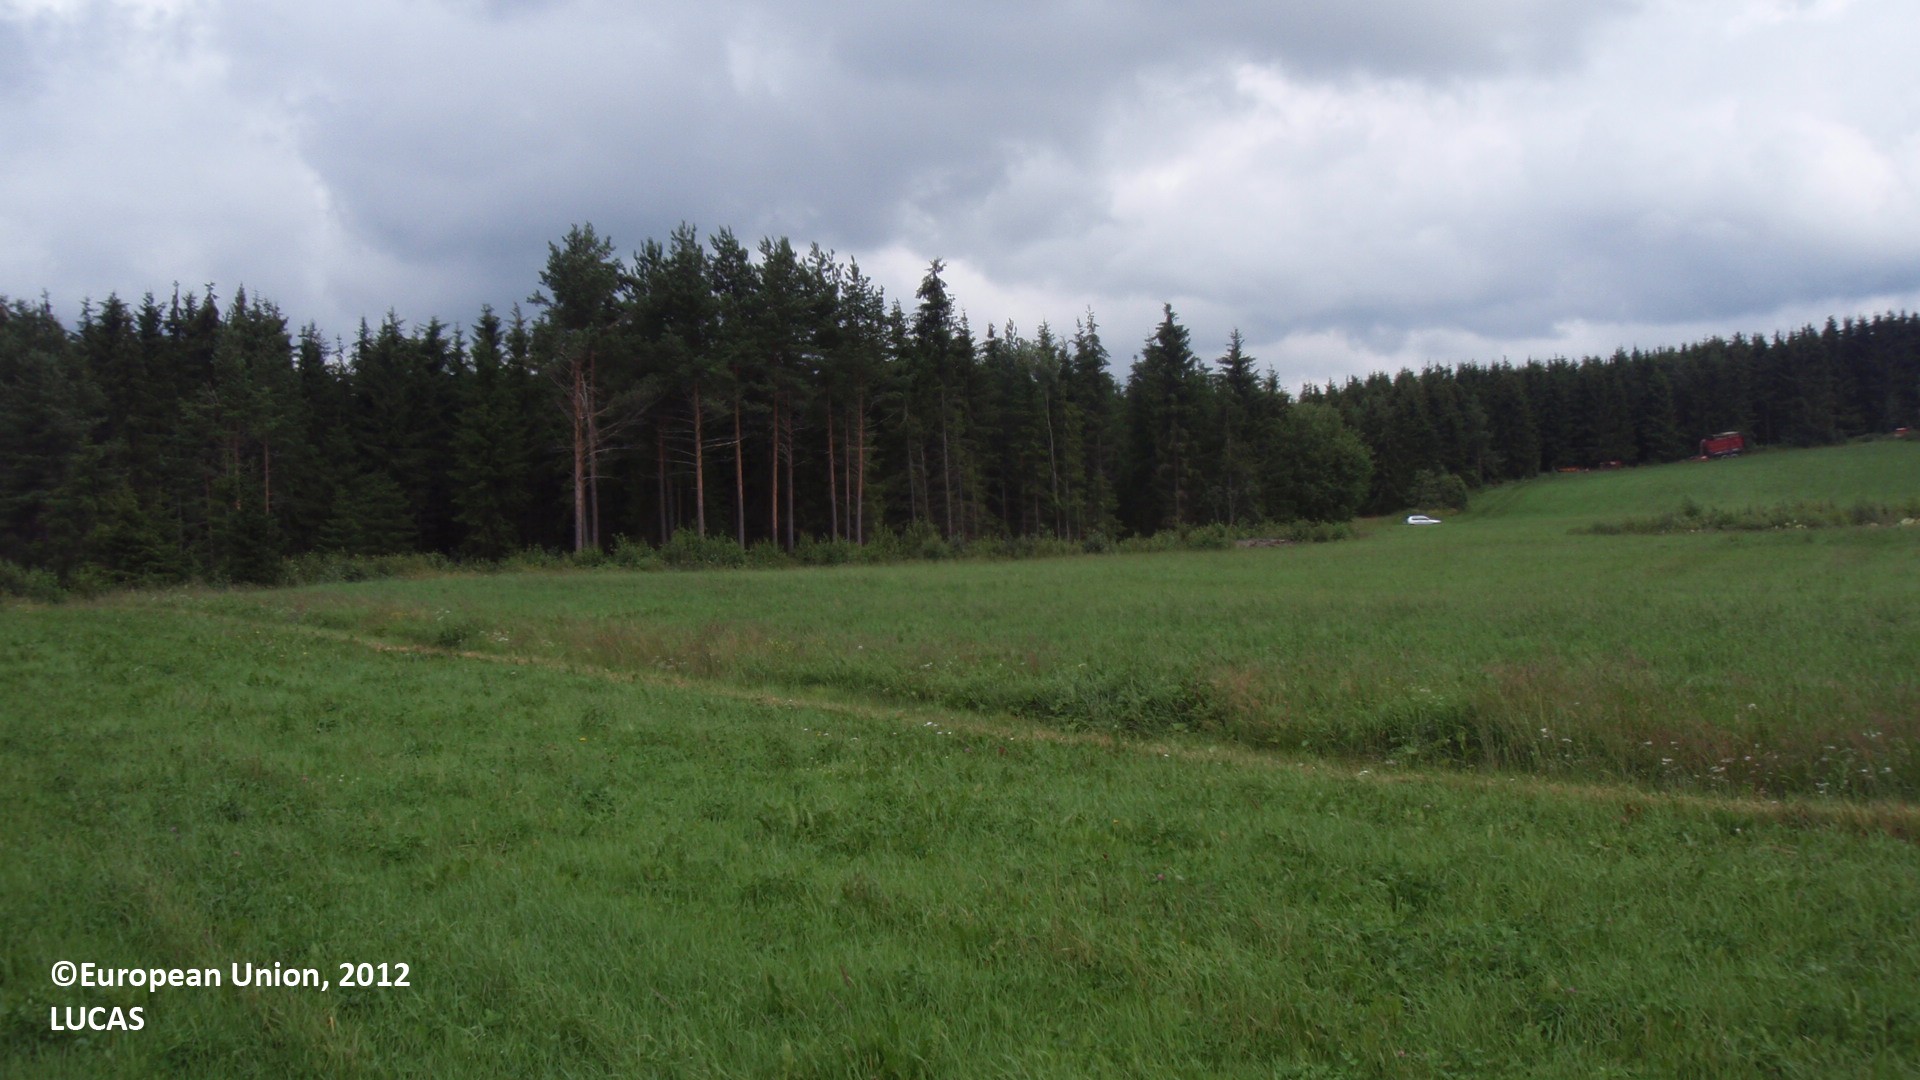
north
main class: Cropland
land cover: Temporary grasslands
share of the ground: > 75 %
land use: Agriculture (excluding fallow land and kitchen gardens)
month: July
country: FI
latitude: 61.0578
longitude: 28.4999
